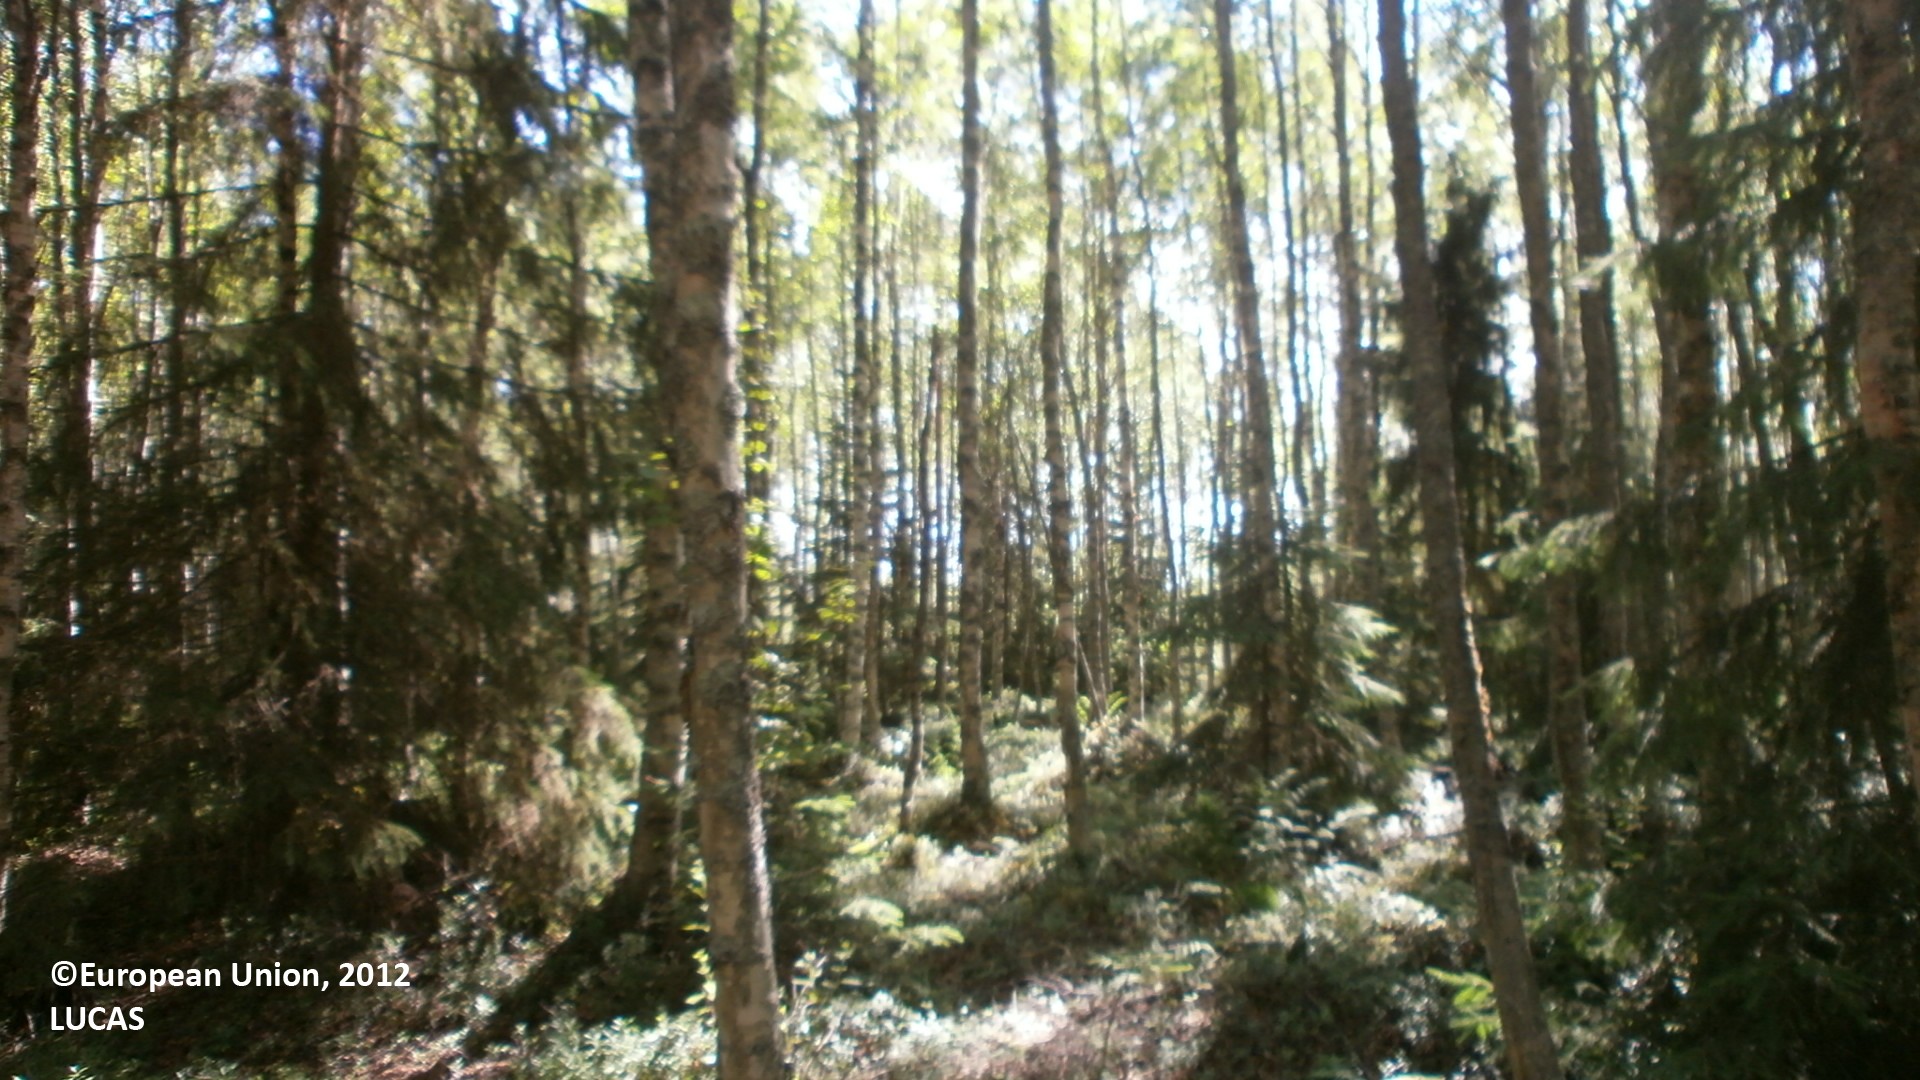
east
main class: Woodland
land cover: Broadleaved woodland
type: boreal forest
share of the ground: > 75 %
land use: Forestry
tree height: > 5 m
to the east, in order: Broadleaved woodland; Ditches and canals; Broadleaved woodland; Pine dominated mixed woodland; Pine dominated coniferous woodland; Pine dominated mixed woodland; Ditches and canals; Pine dominated mixed woodland
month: July
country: FI
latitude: 64.2810
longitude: 24.0877
